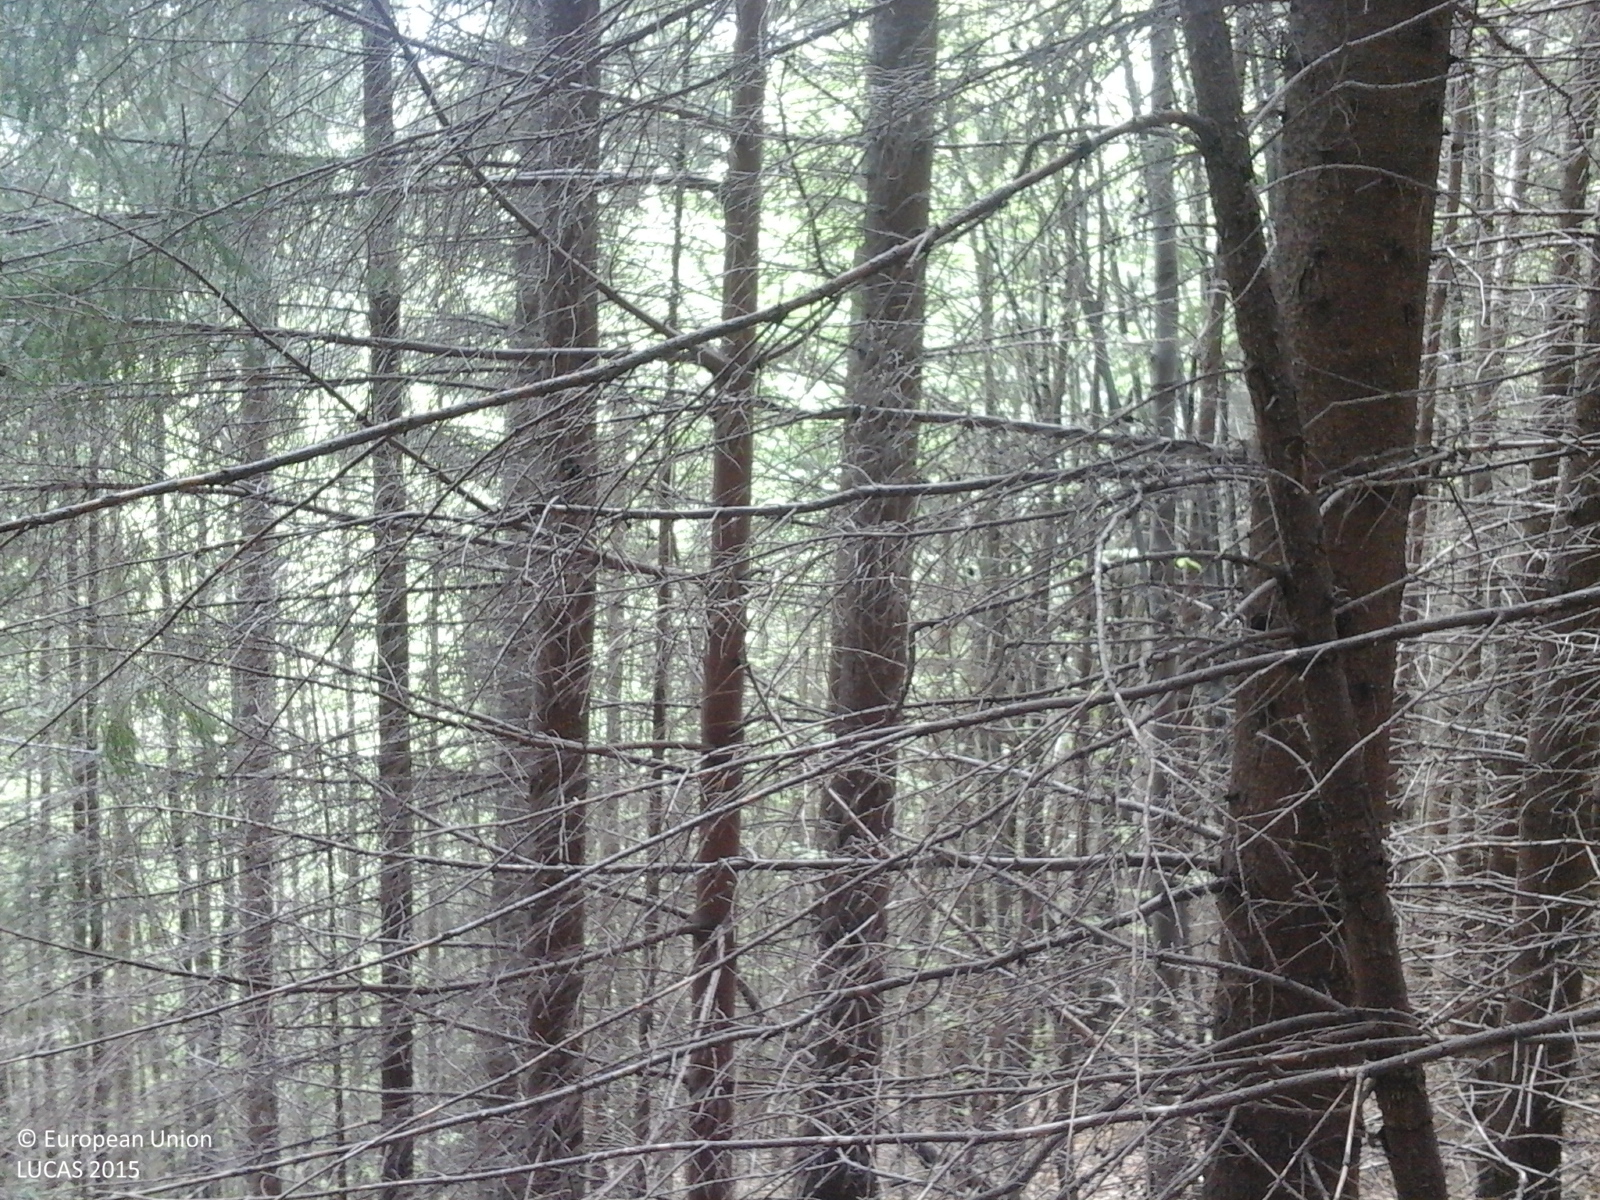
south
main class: Woodland
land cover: Spruce dominated mixed woodland
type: alpine coniferous forest
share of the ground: > 75 %
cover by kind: coniferous forest trees 50 %, broadleaved forest trees 50 %
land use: Forestry
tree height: > 5 m
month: May
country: RO
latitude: 45.5686
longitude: 25.9362
